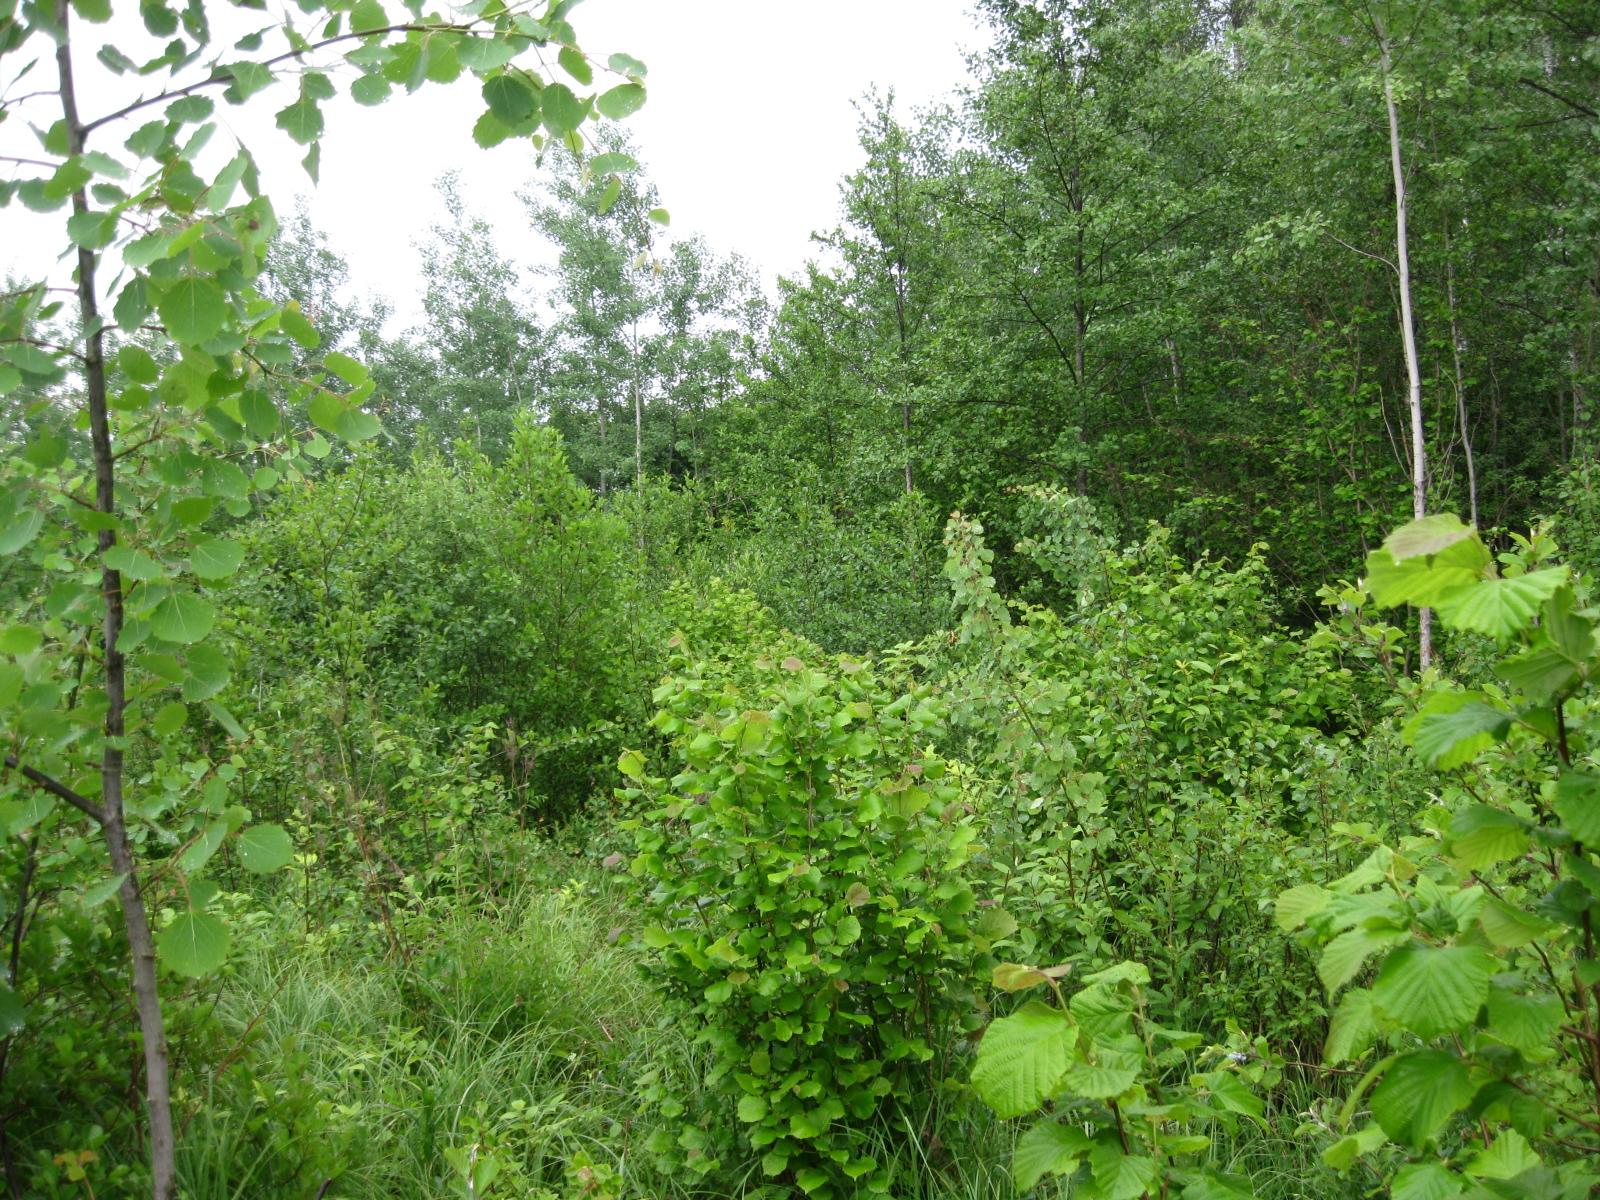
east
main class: Woodland
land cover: Broadleaved woodland
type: non-riverine alder, birch or aspen forest
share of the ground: > 75 %
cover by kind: broadleaved forest trees 80 %, herbaceous plants 15 %, shrubs 5 %
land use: Forestry
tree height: < 5 m
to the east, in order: Broadleaved woodland
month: June
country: LT
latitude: 55.6532
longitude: 23.9945
